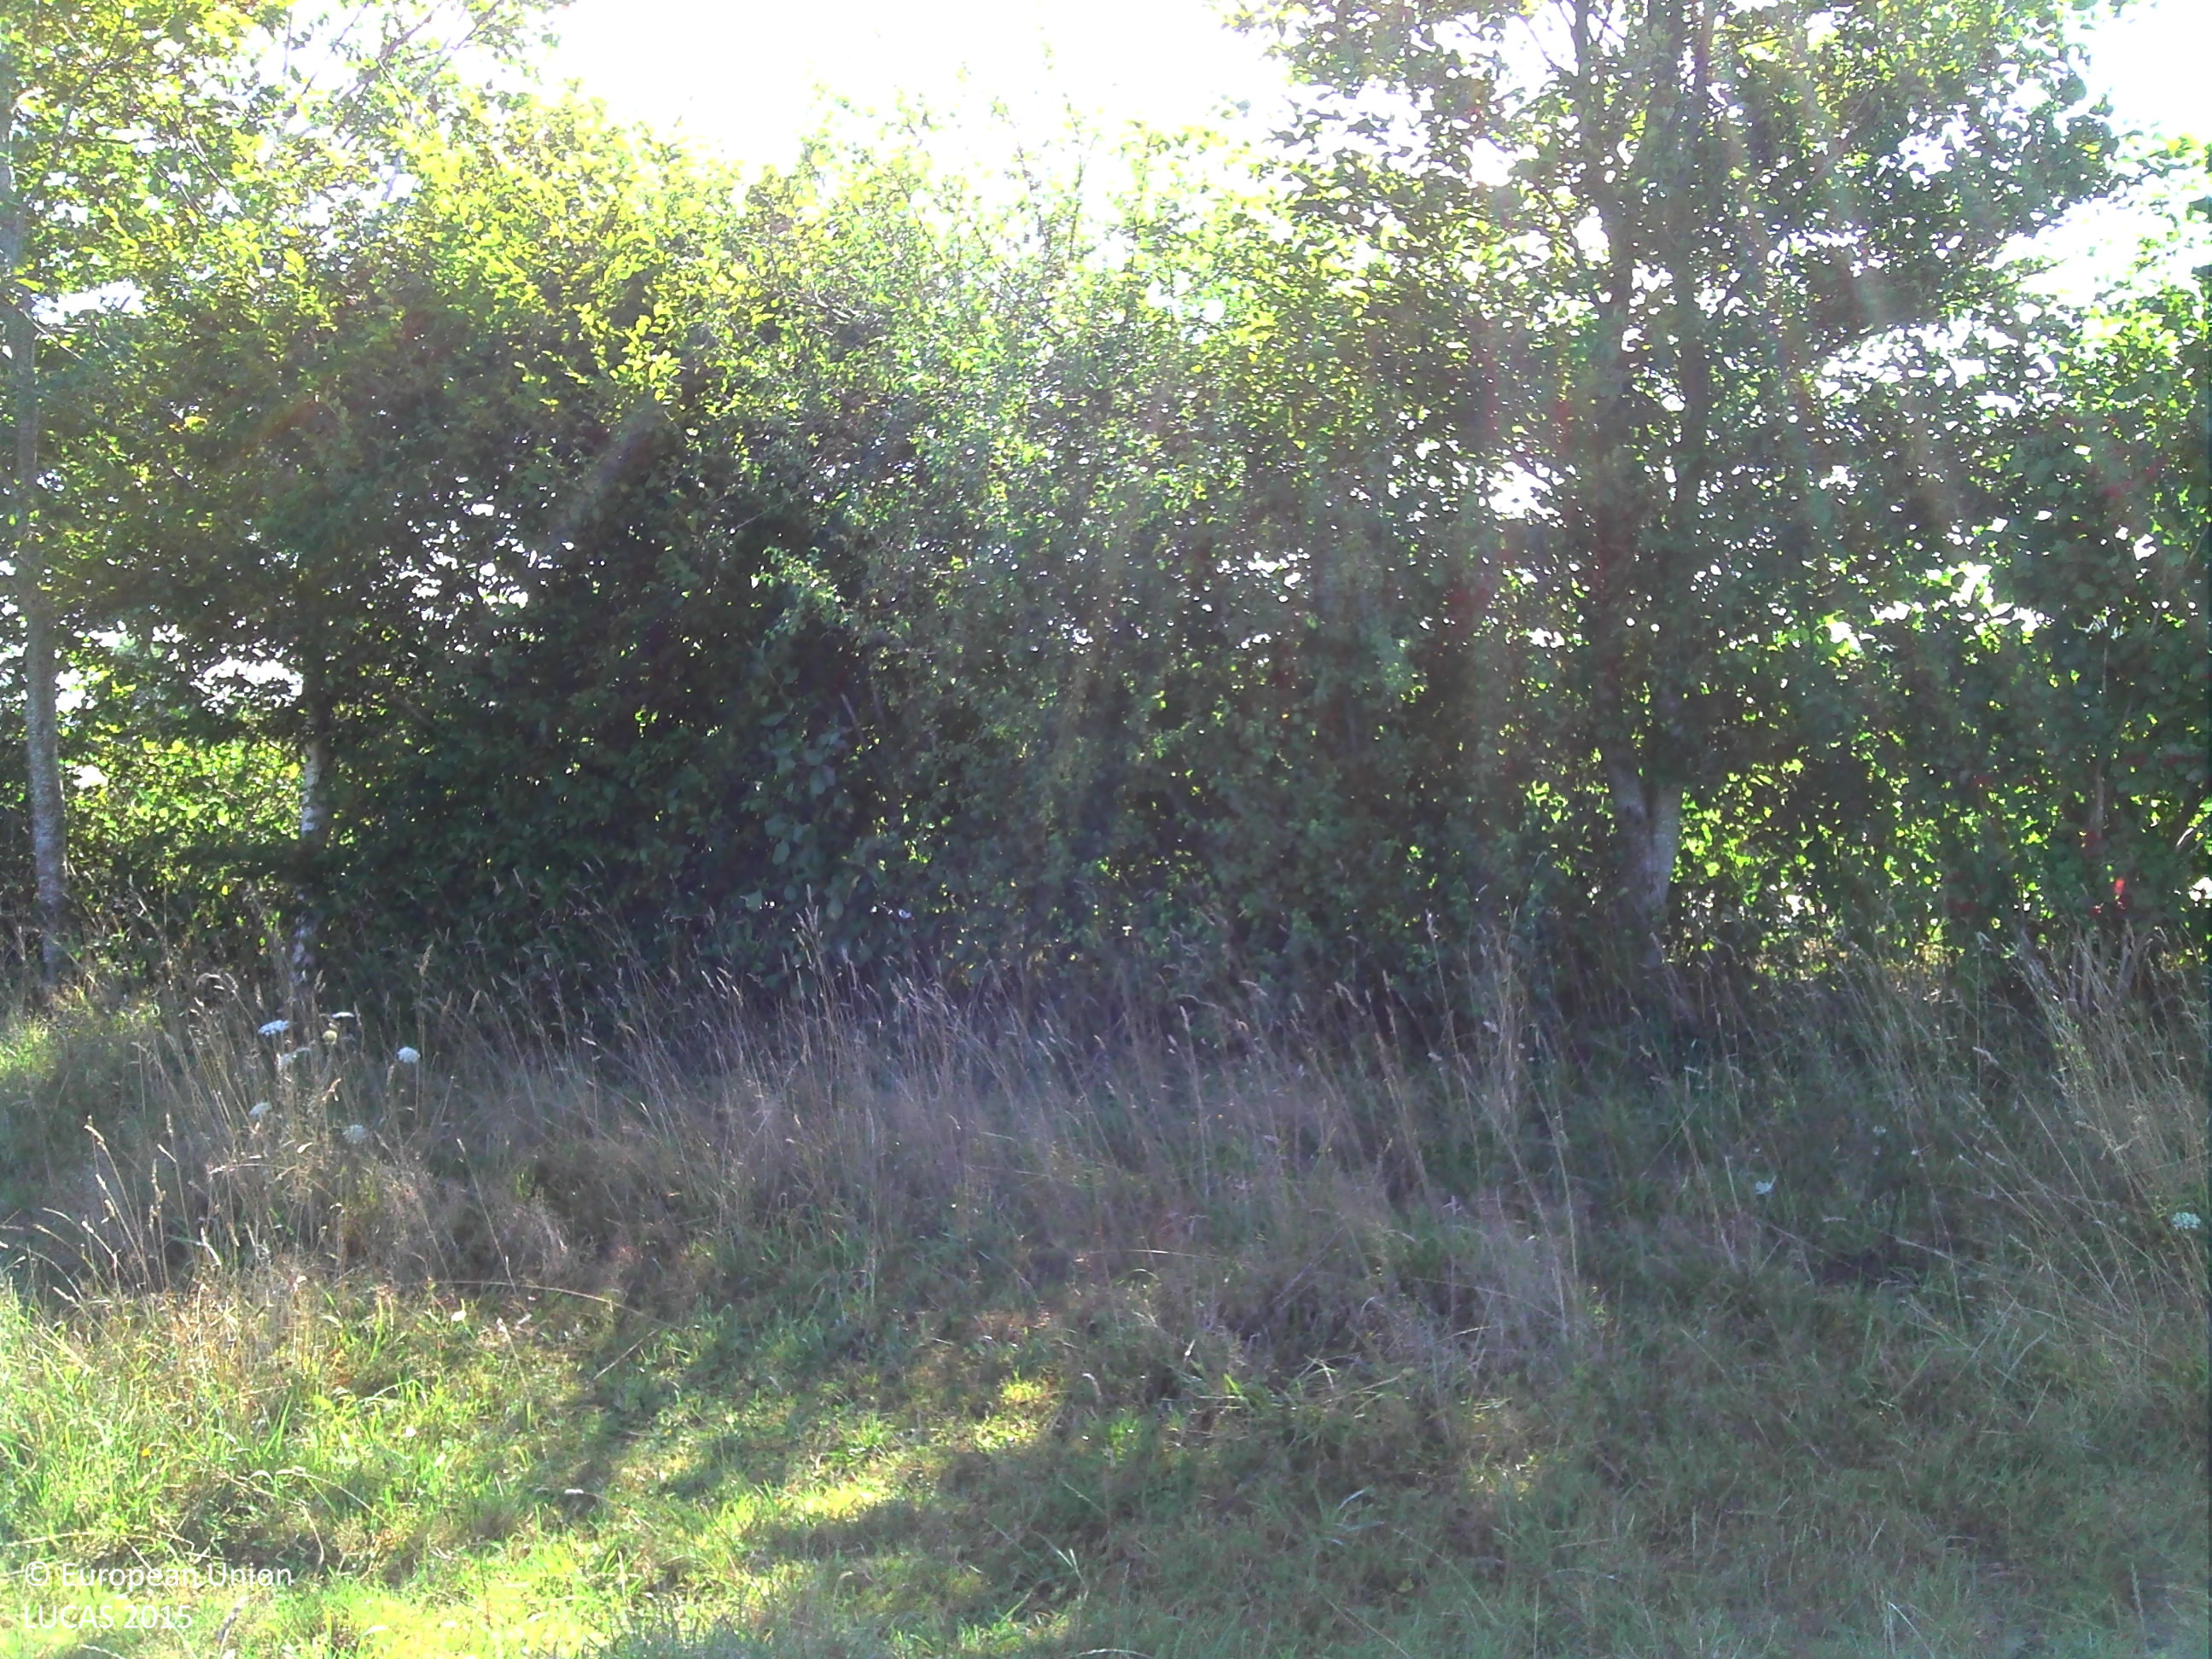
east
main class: Grassland
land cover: Grassland without tree/shrub cover
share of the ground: > 75 %
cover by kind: herbaceous plants 80 %, consolidated bare surface 20 %
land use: Agriculture (excluding fallow land and kitchen gardens)
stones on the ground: 10 - 25 %
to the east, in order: Grassland without tree/shrub cover; Fences; Lines of trees; Grass margins; Paved roads, cycling and walking lanes; Grass margins; Grassland without tree/shrub cover; Electric lines; Grassland without tree/shrub cover; Maize; Grassland without tree/shrub cover; Maize
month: July
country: FR
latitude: 47.6814
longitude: -2.8924
